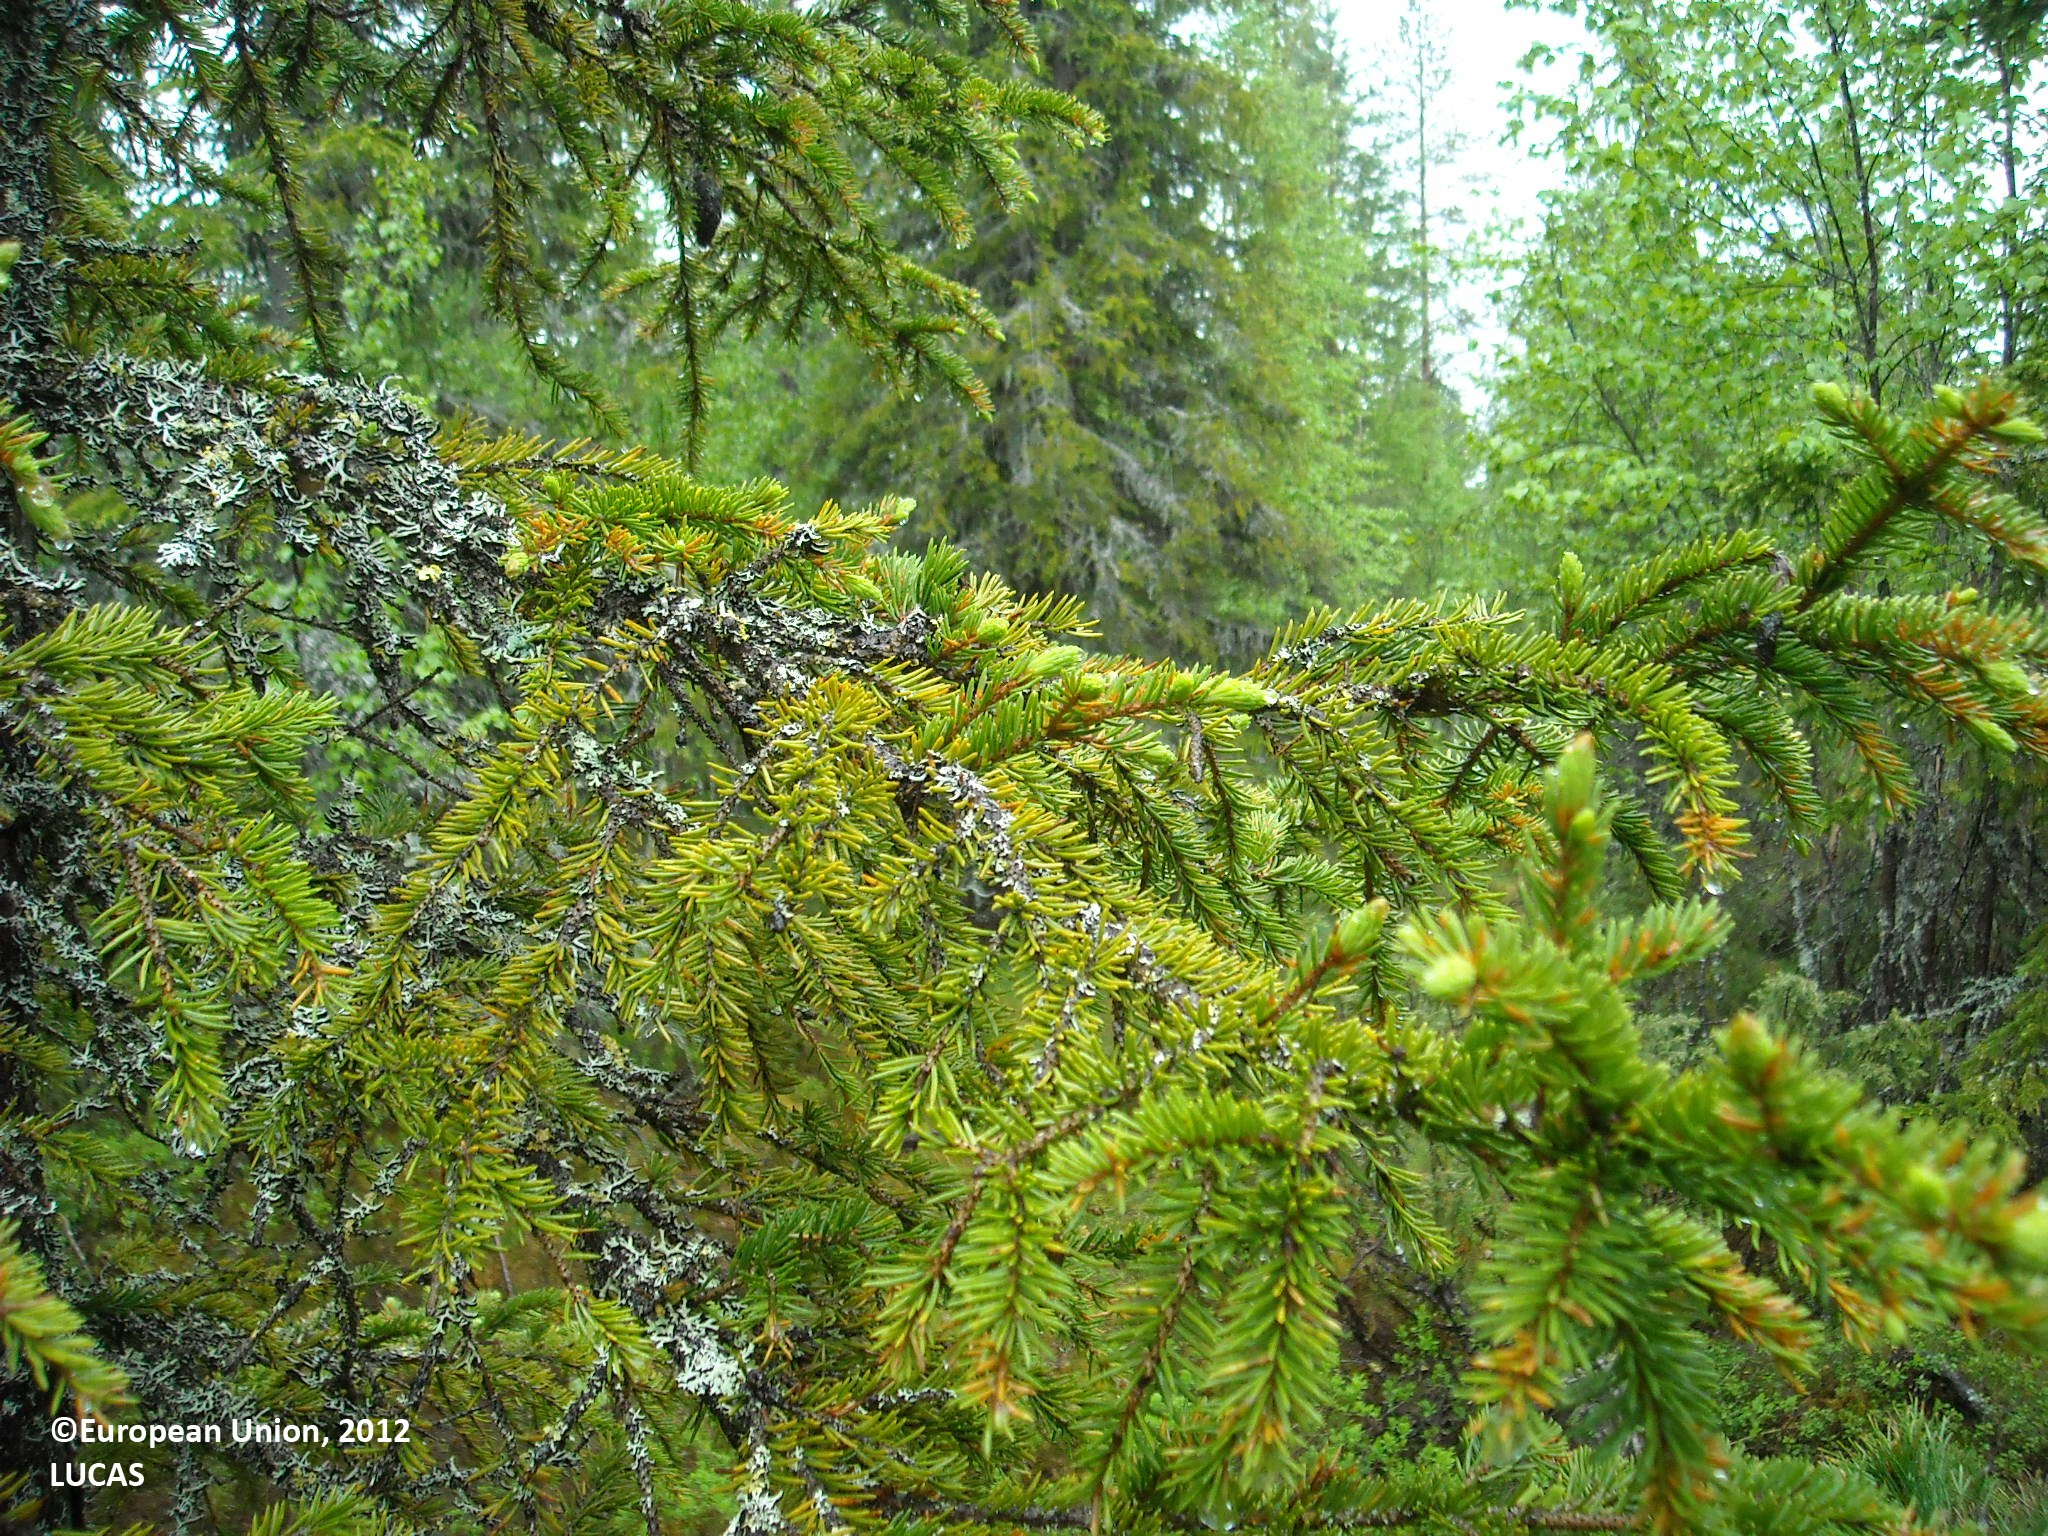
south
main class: Woodland
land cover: Other mixed woodland
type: boreal forest
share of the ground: > 75 %
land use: Forestry
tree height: > 5 m
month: June
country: FI
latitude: 65.5816
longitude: 27.9401
